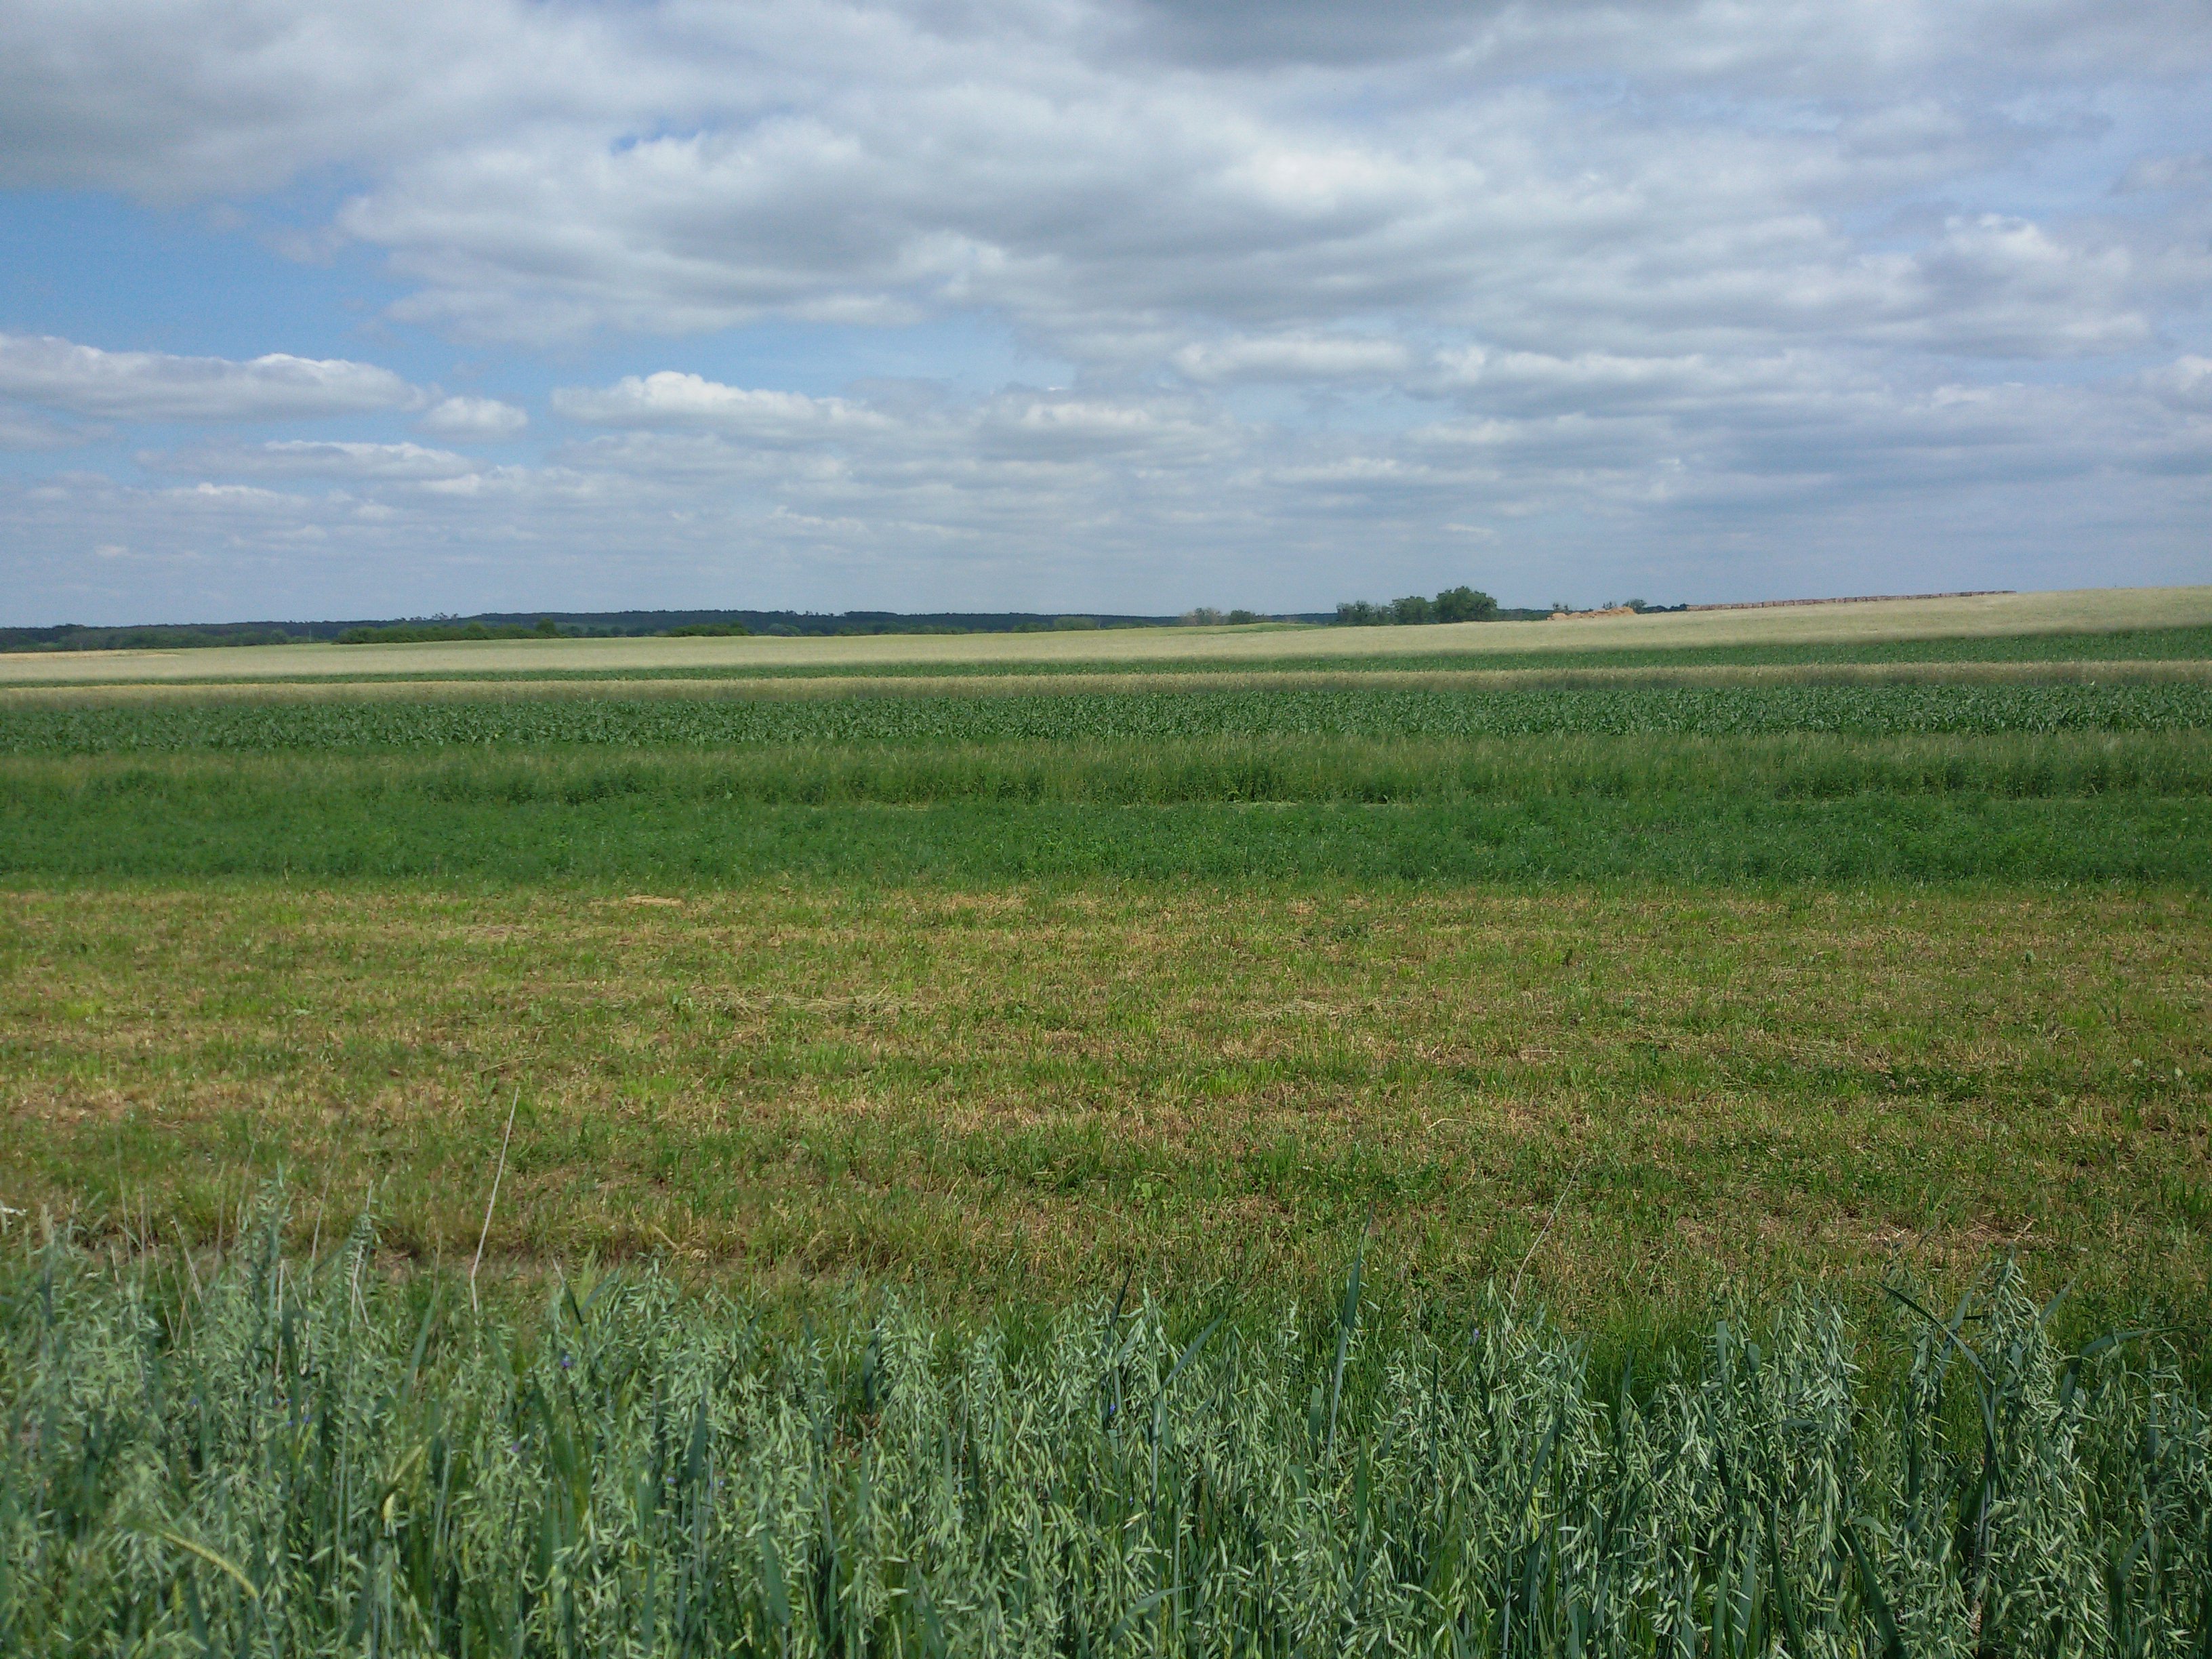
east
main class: Cropland
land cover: Barley
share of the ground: 50 - 75 %
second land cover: Oats
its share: 50 - 75 %
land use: Agriculture (excluding fallow land and kitchen gardens)
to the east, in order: Barley; Oats; Grassland without tree/shrub cover; Potatoes; Triticale; Maize; Rye
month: June
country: PL
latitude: 52.0021
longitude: 17.1044
